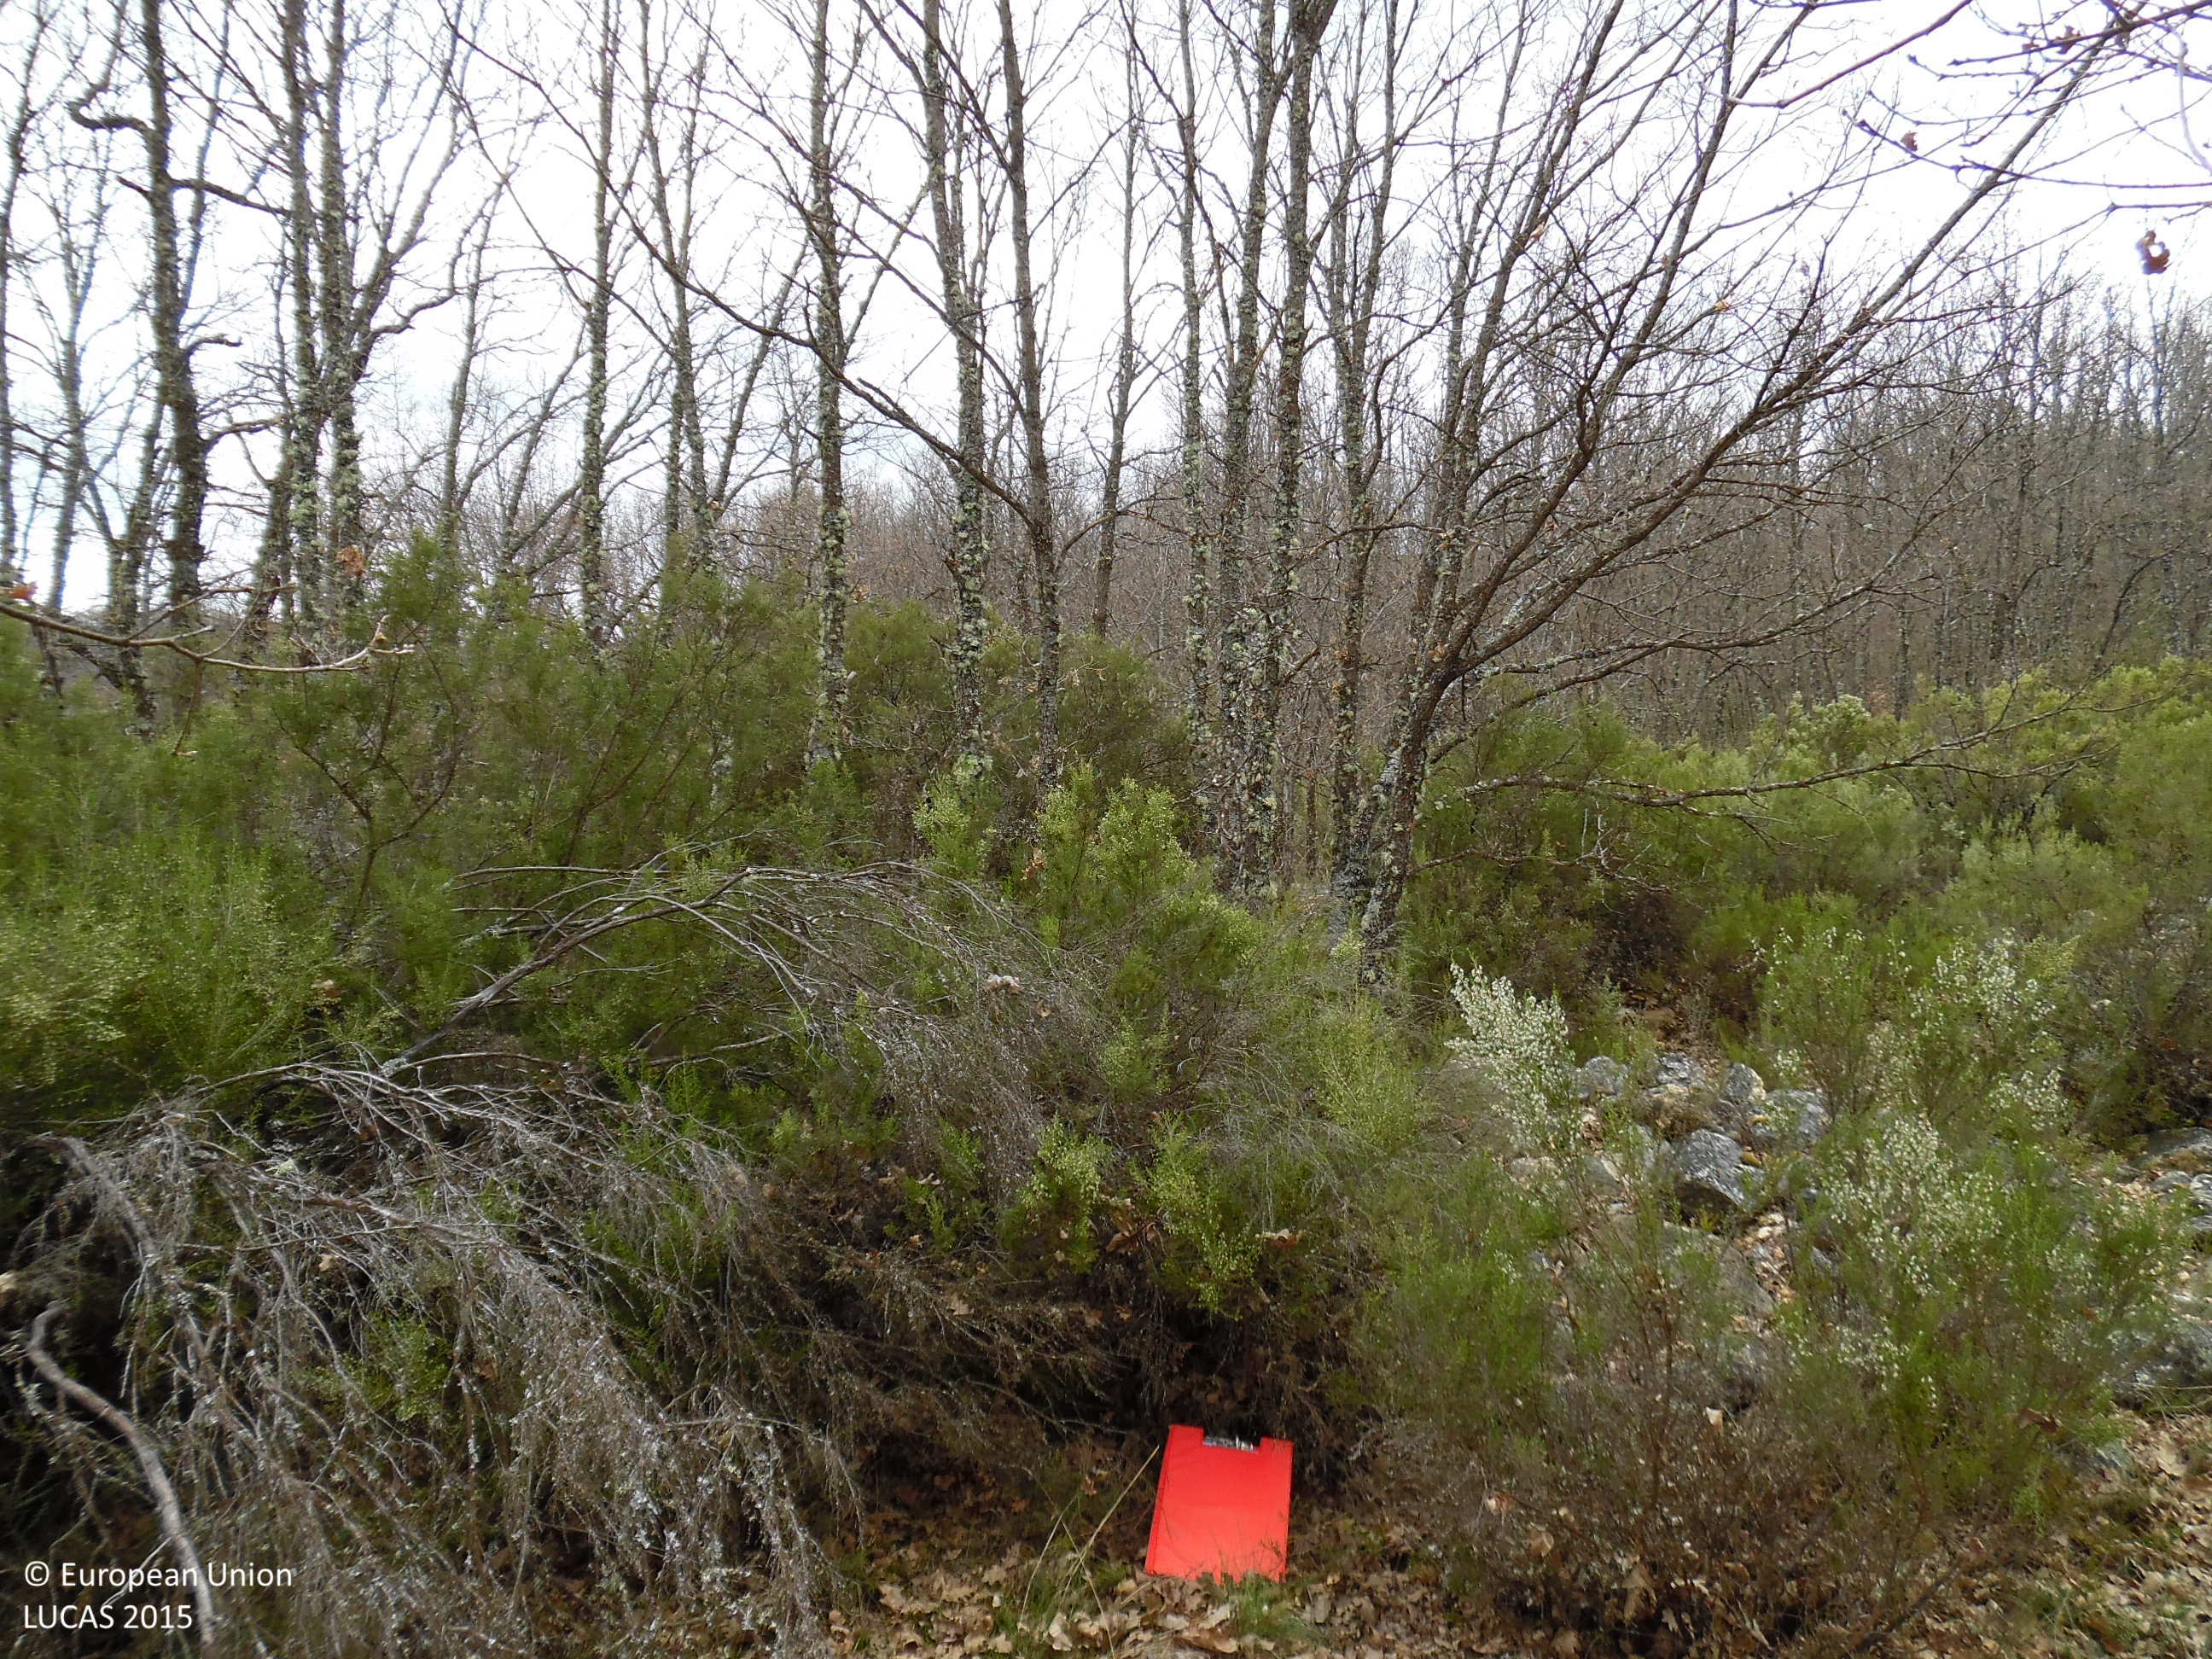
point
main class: Woodland
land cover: Broadleaved woodland
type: acidophilous oak and oak-birch forest
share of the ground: > 75 %
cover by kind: broadleaved forest trees 95 %, shrubs 5 %
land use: Forestry
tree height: > 5 m
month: April
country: ES
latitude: 42.3853
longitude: -6.3264
